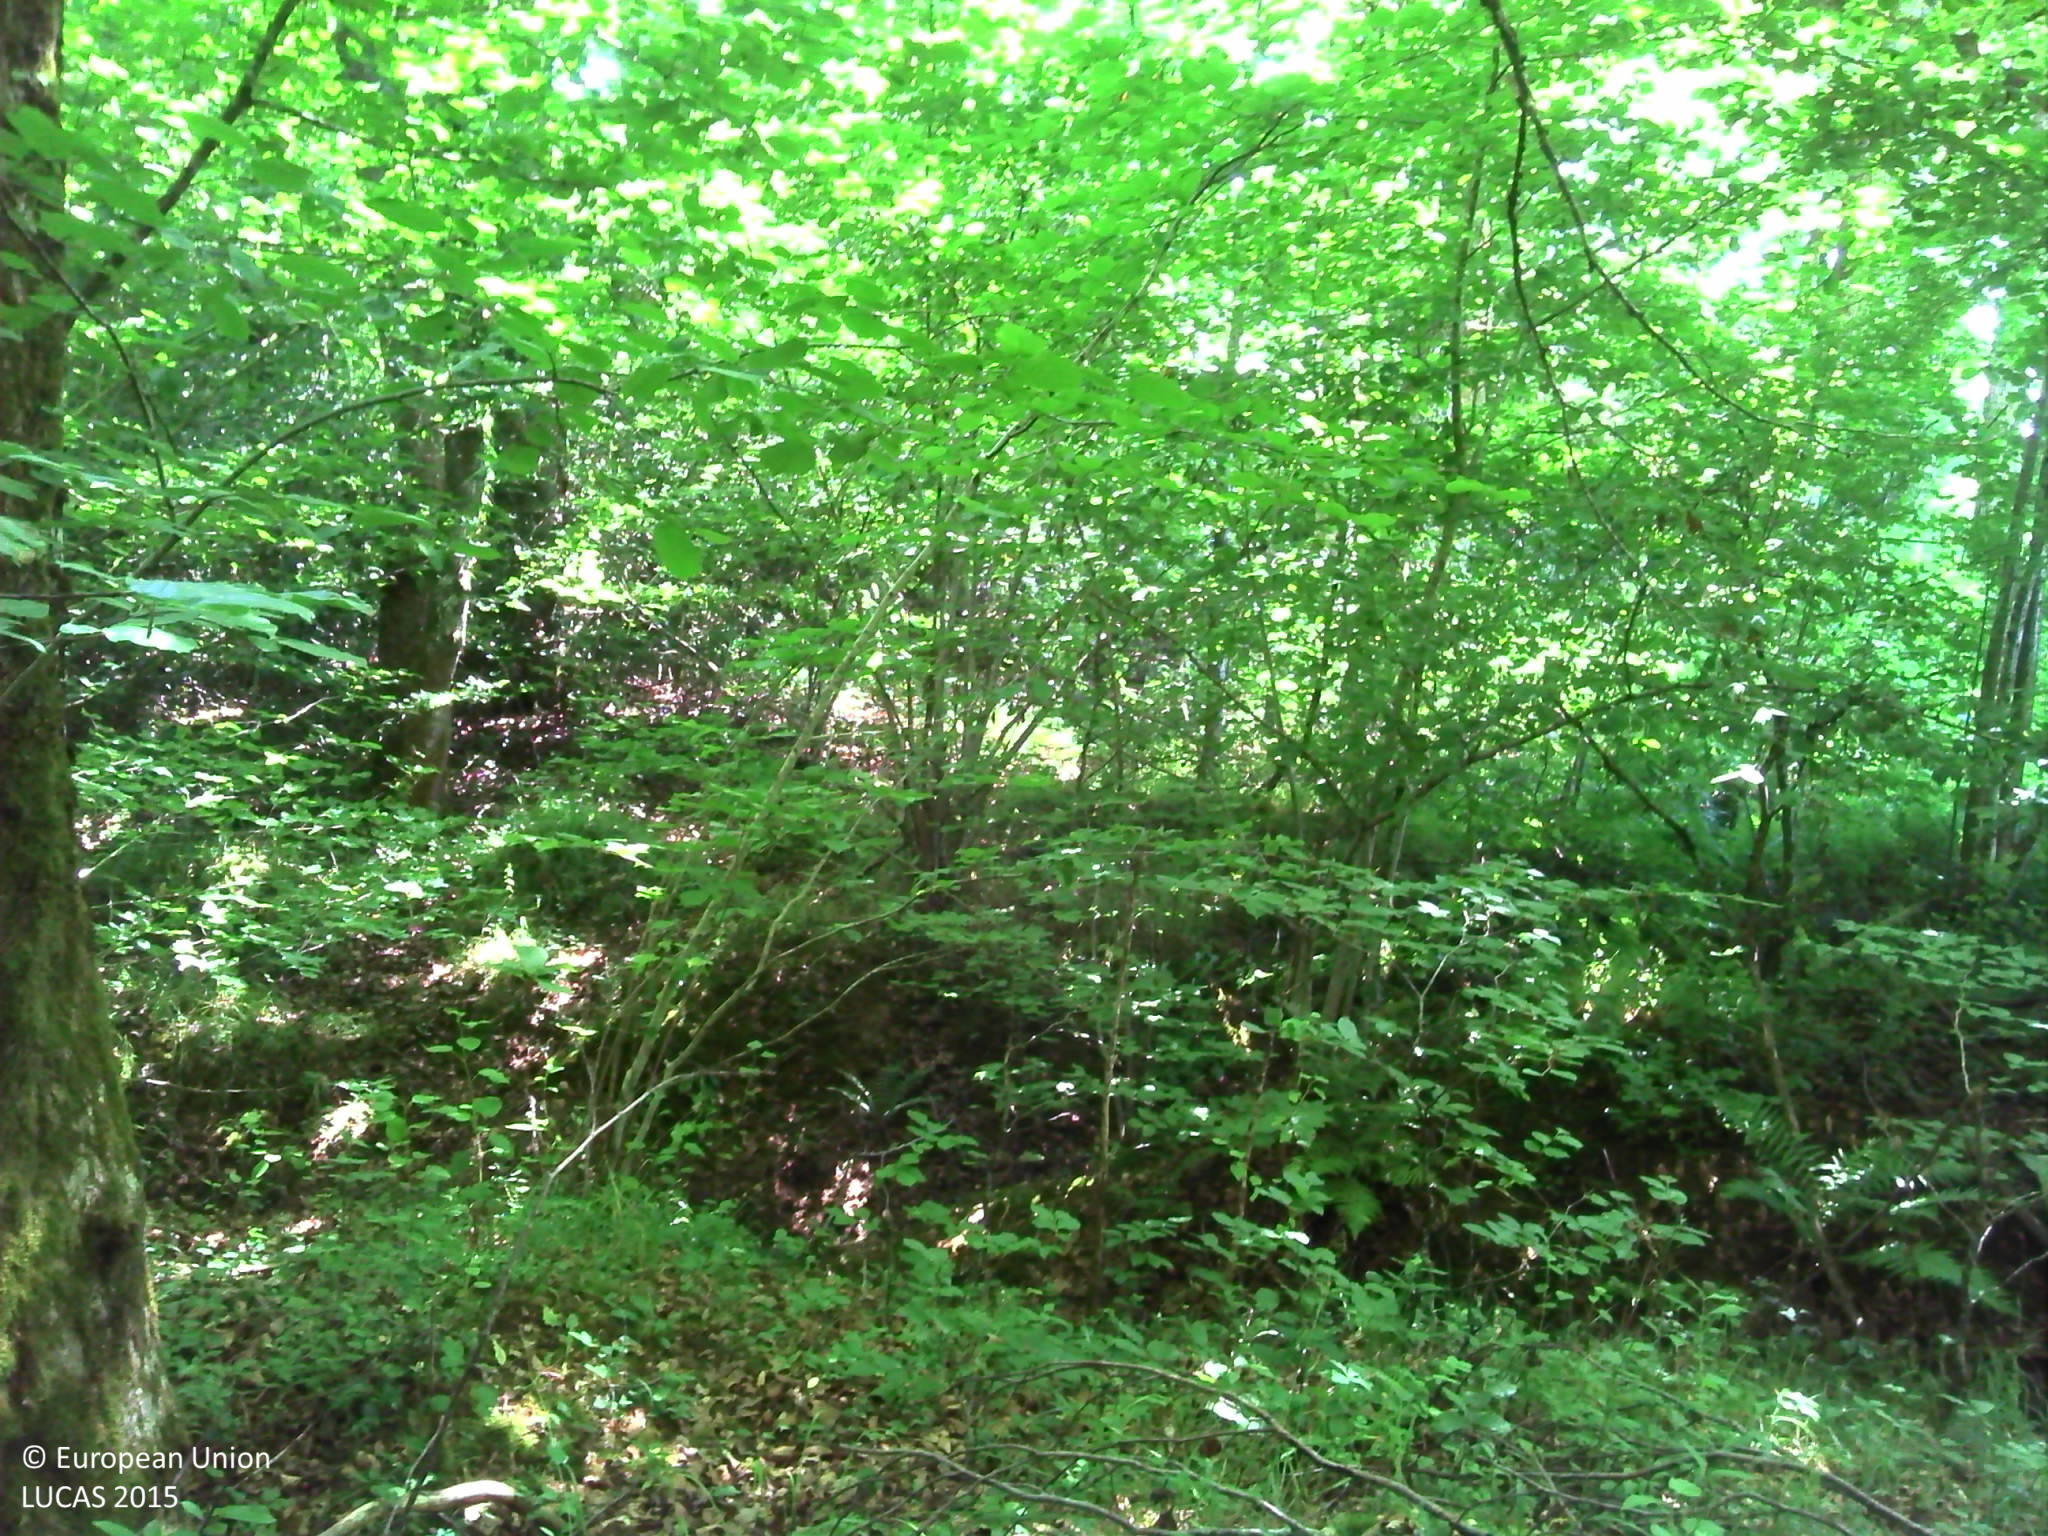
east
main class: Woodland
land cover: Broadleaved woodland
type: acidophilous oak and oak-birch forest
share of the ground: > 75 %
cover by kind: broadleaved forest trees 80 %, shrubs 15 %, herbaceous plants 5 %
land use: Forestry
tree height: > 5 m
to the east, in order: Broadleaved woodland; Ditches and canals; Broadleaved woodland; Fences; Broadleaved woodland; Grassland without tree/shrub cover; Lines of trees; Tracks; Temporary grasslands; Abandoned hedges; Fences; Grassland without tree/shrub cover
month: June
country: FR
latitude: 44.9036
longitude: 2.3889
